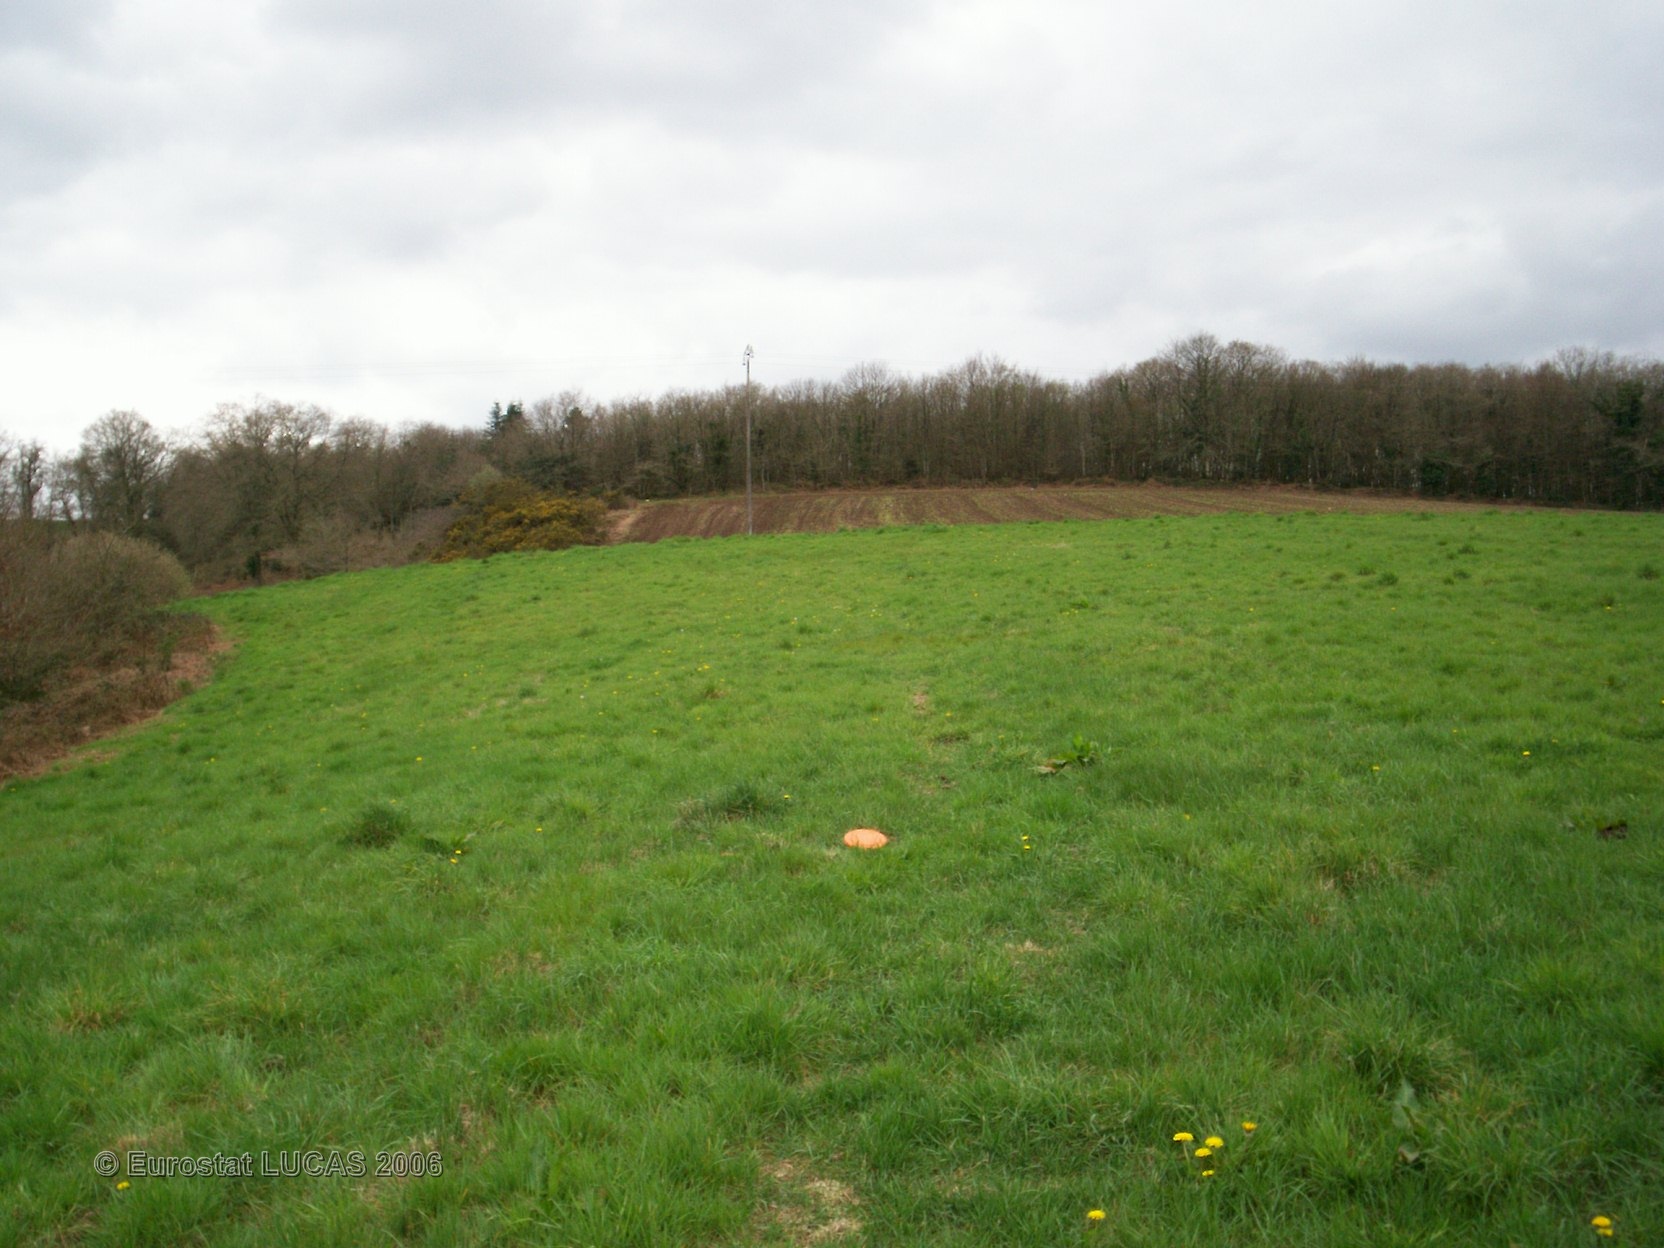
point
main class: Grassland
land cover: Grassland without tree/shrub cover
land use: Agriculture (excluding fallow land and kitchen gardens)
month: April
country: FR
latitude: 47.9883
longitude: -3.5166
